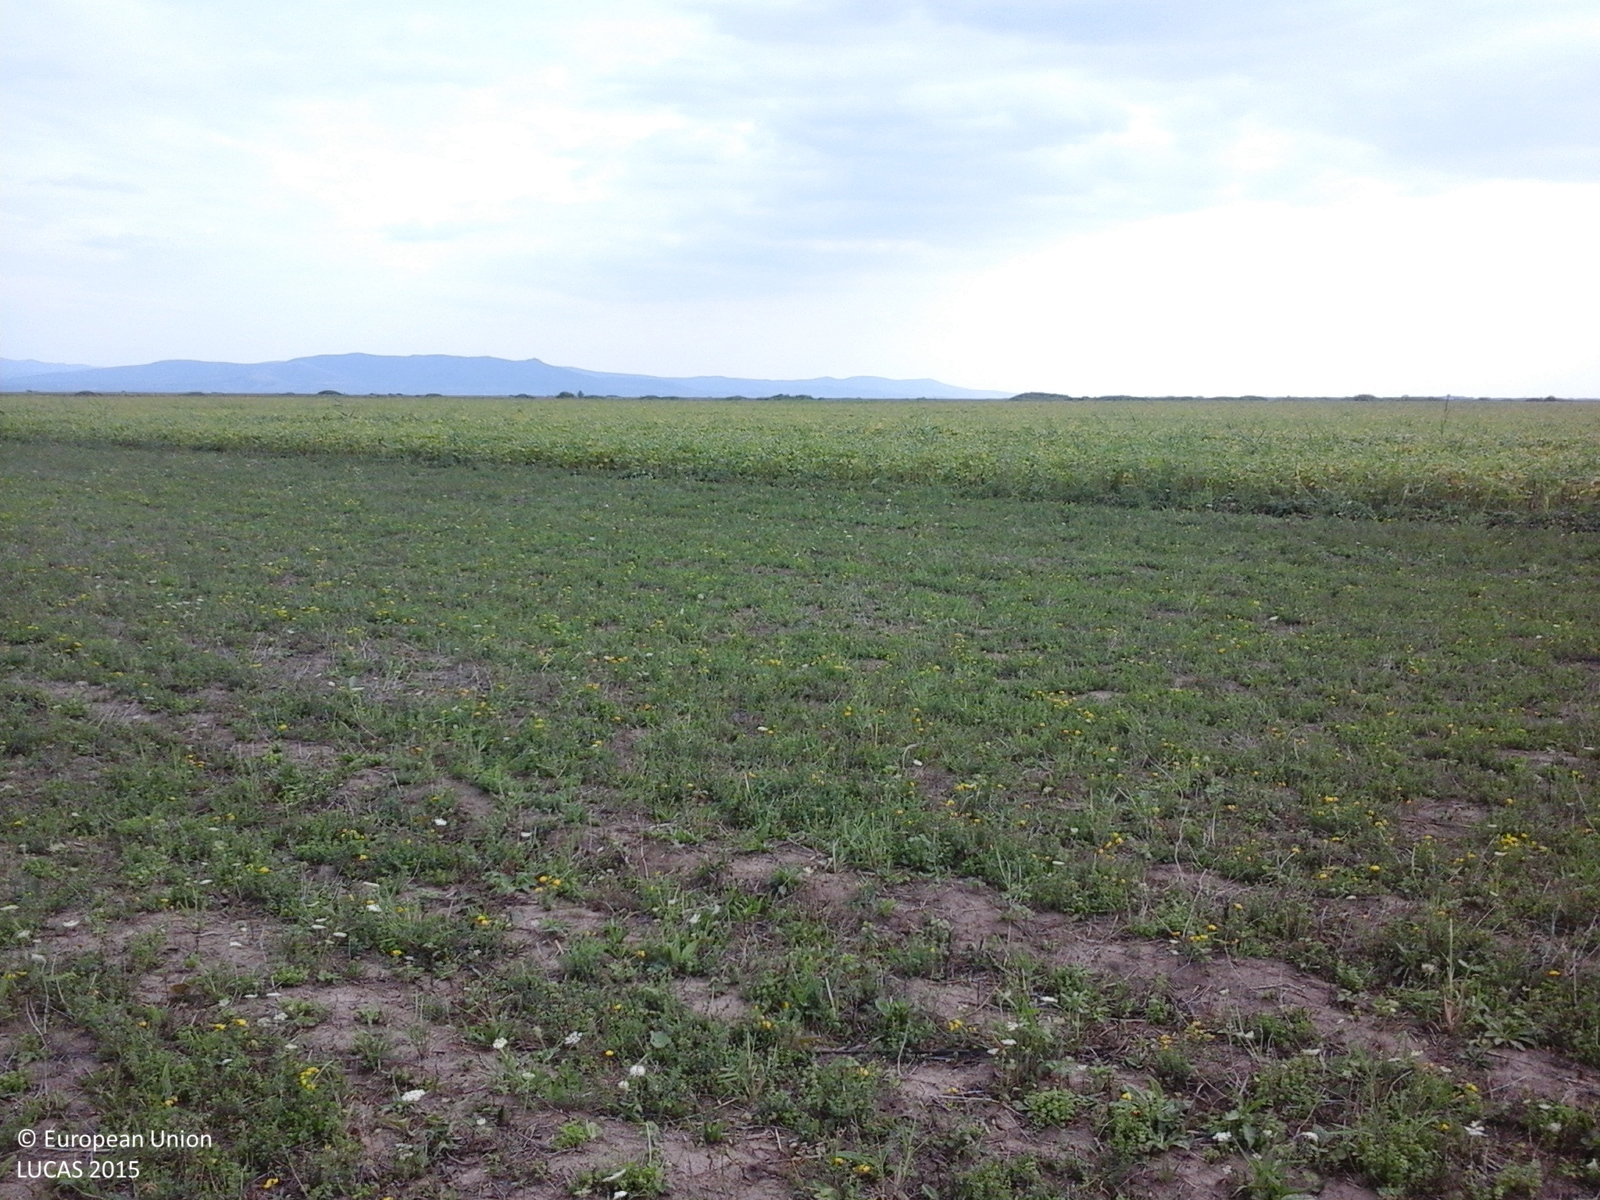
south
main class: Grassland
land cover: Spontaneously vegetated surfaces
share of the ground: > 75 %
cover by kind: herbaceous plants 100 %
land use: Fallow land
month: August
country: RO
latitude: 46.3908
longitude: 21.5993
